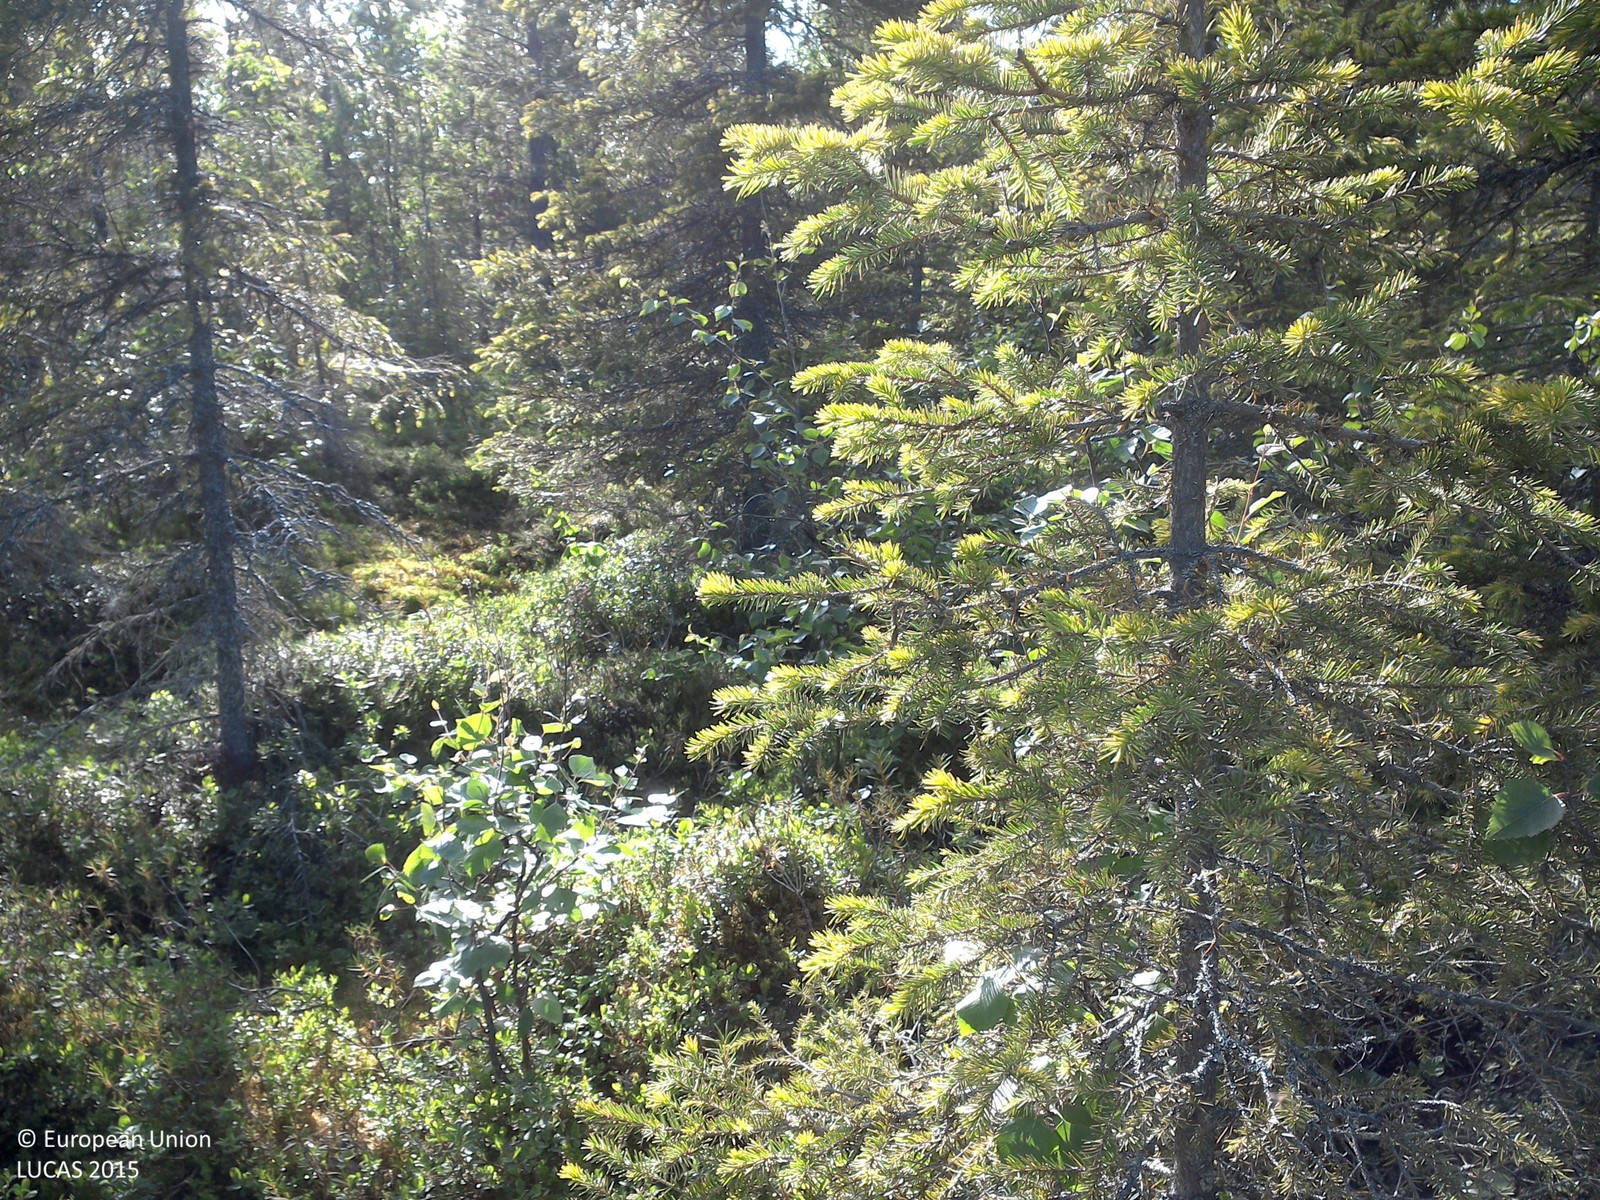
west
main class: Woodland
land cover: Spruce dominated mixed woodland
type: boreal forest
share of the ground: 25 - 50 %
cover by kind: shrubs 55 %, coniferous forest trees 20 %, broadleaved forest trees 10 %, lichens and mosses 10 %, herbaceous plants 5 %
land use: Forestry
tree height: > 5 m
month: July
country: SE
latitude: 67.1647
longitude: 22.8277
